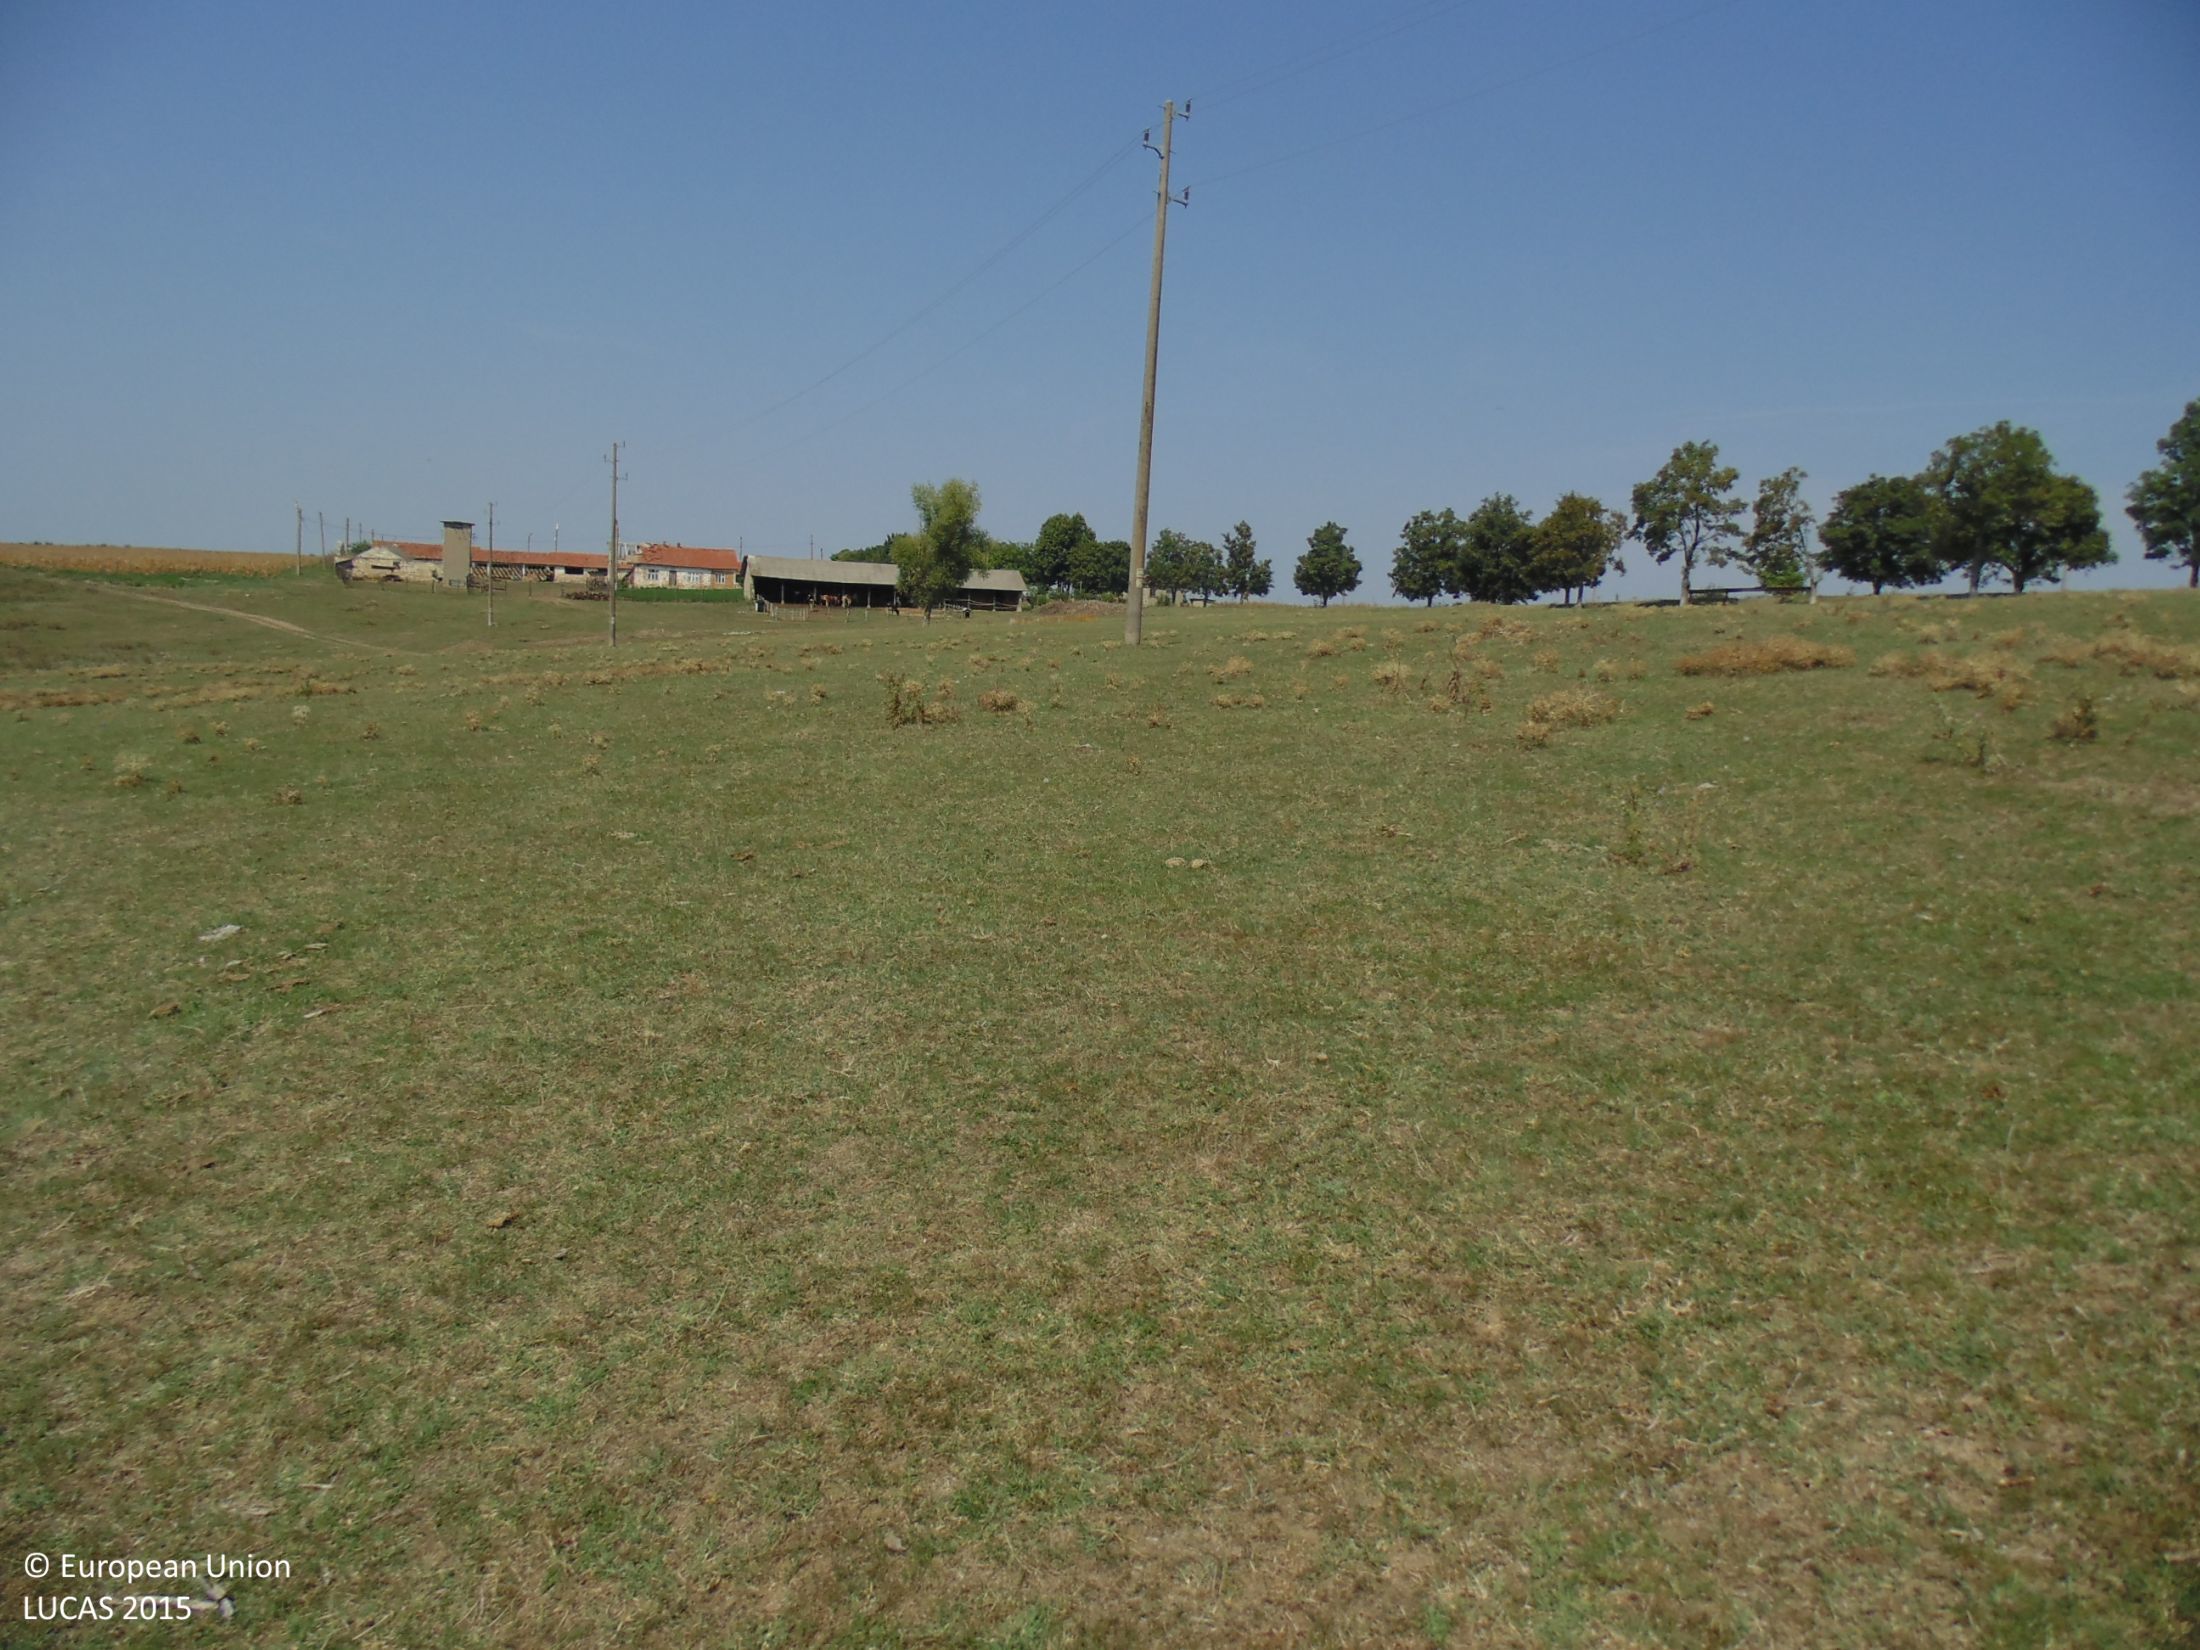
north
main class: Grassland
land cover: Grassland without tree/shrub cover
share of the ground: > 75 %
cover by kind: herbaceous plants 100 %
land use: Agriculture (excluding fallow land and kitchen gardens)
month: September
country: BG
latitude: 43.7928
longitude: 26.9338
